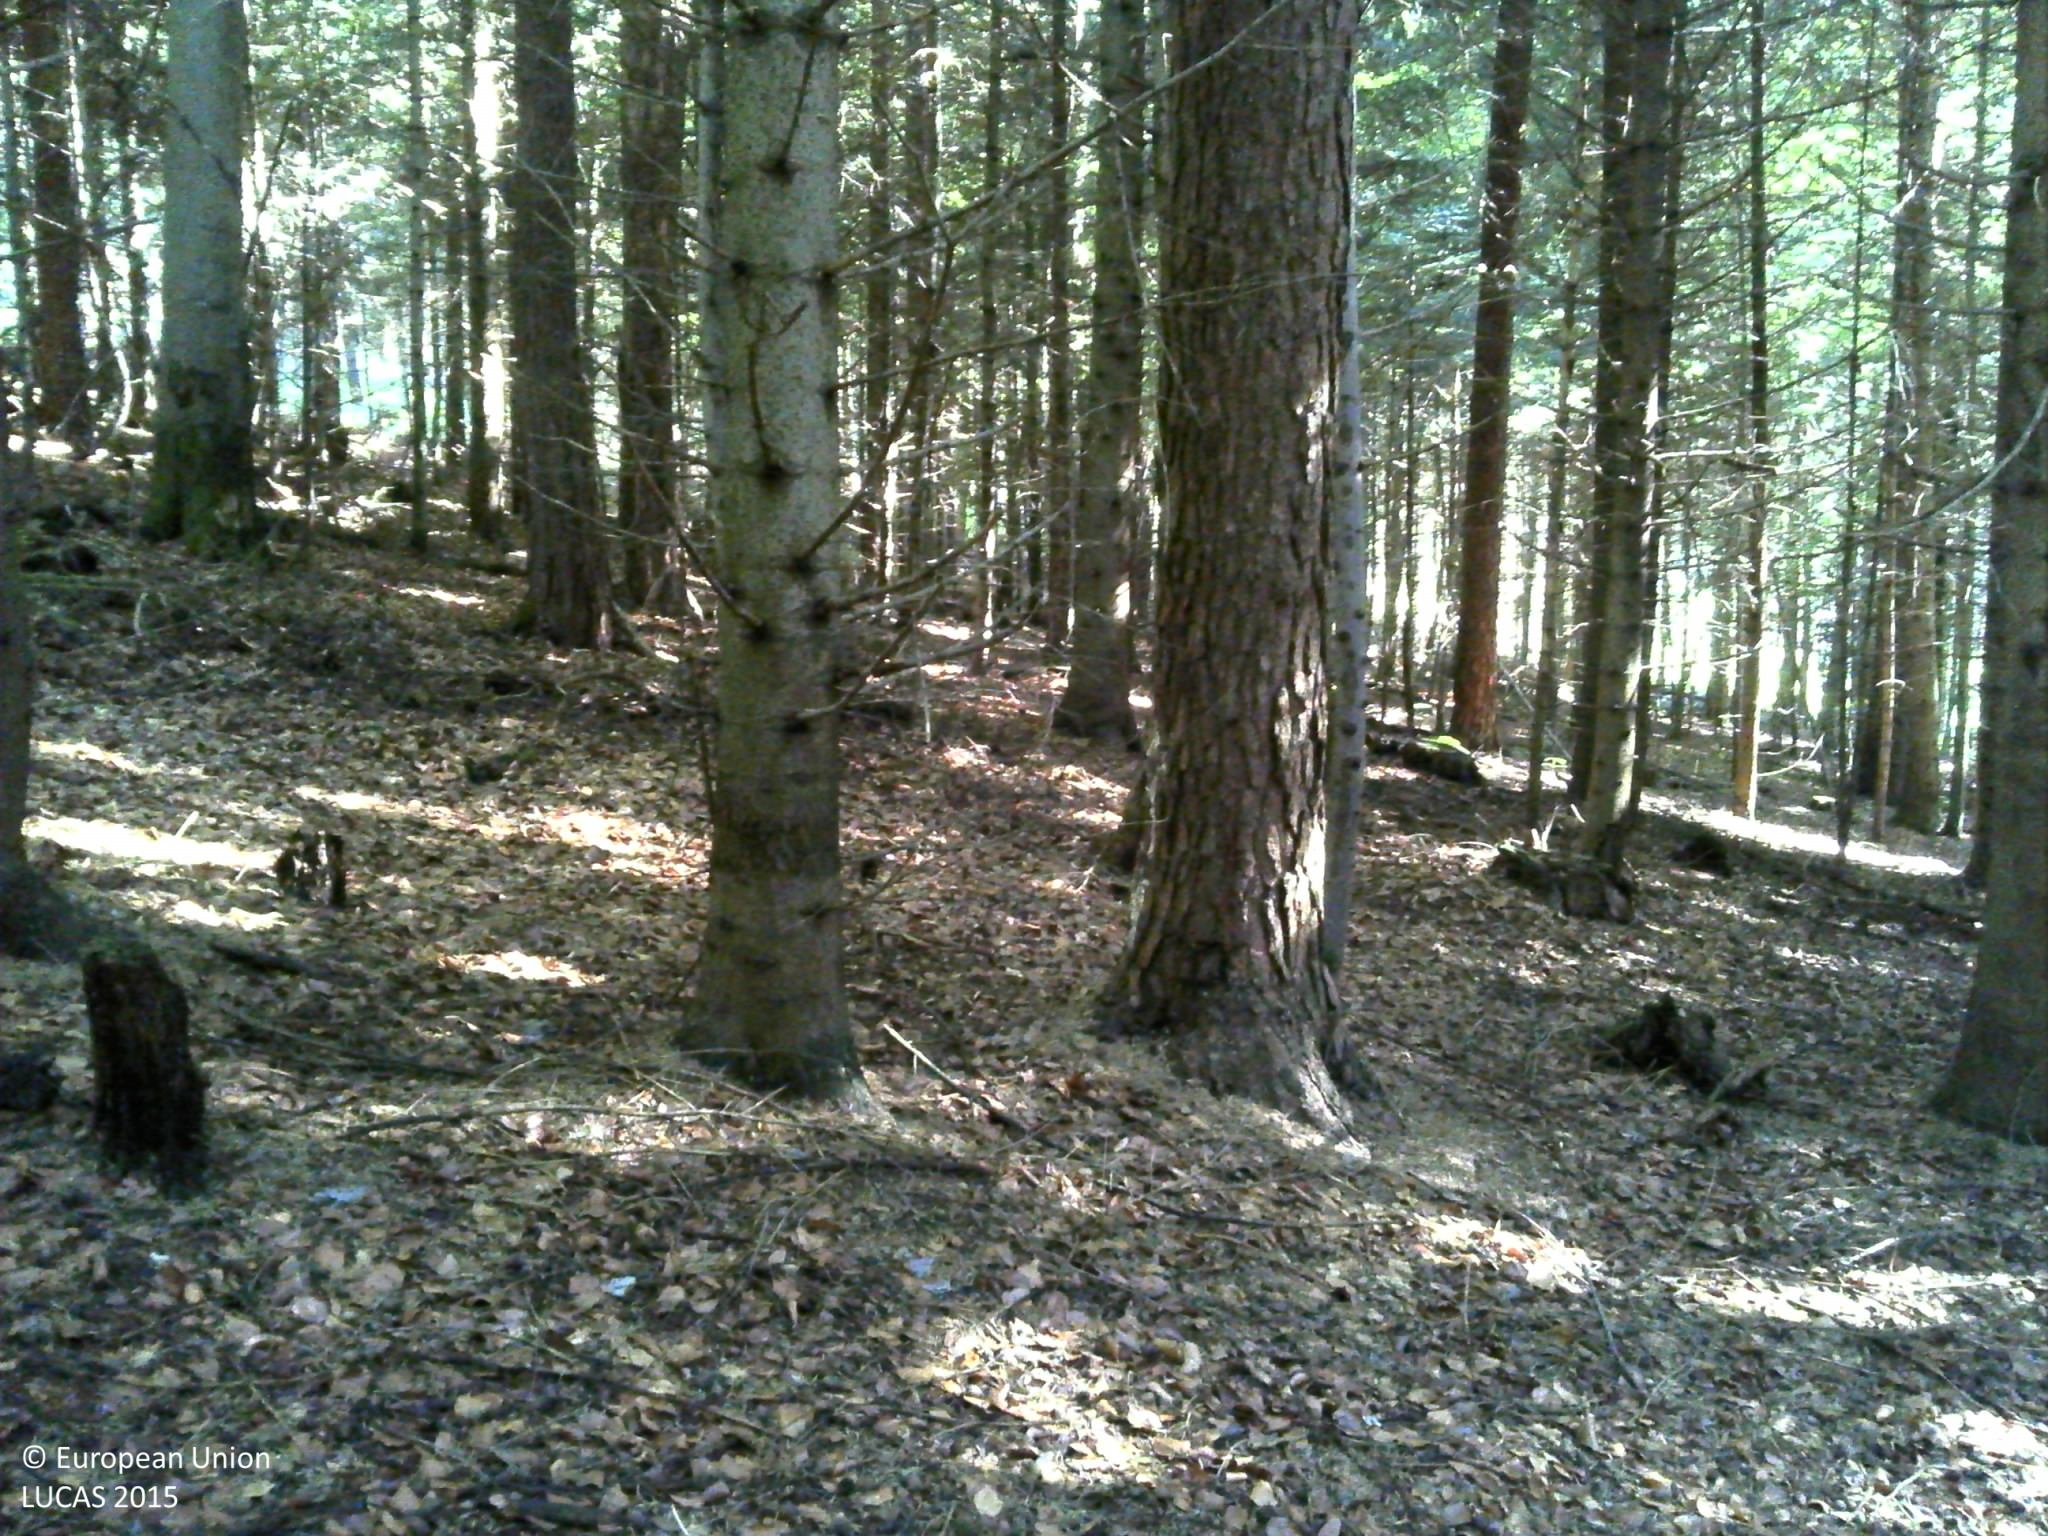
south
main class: Woodland
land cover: Spruce dominated mixed woodland
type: exotic forest
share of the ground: > 75 %
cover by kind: coniferous forest trees 30 %, broadleaved forest trees 20 %, lichens and mosses 20 %, consolidated bare surface 20 %, herbaceous plants 10 %
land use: Forestry
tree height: > 5 m
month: July
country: FR
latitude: 45.4810
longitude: 3.4387
